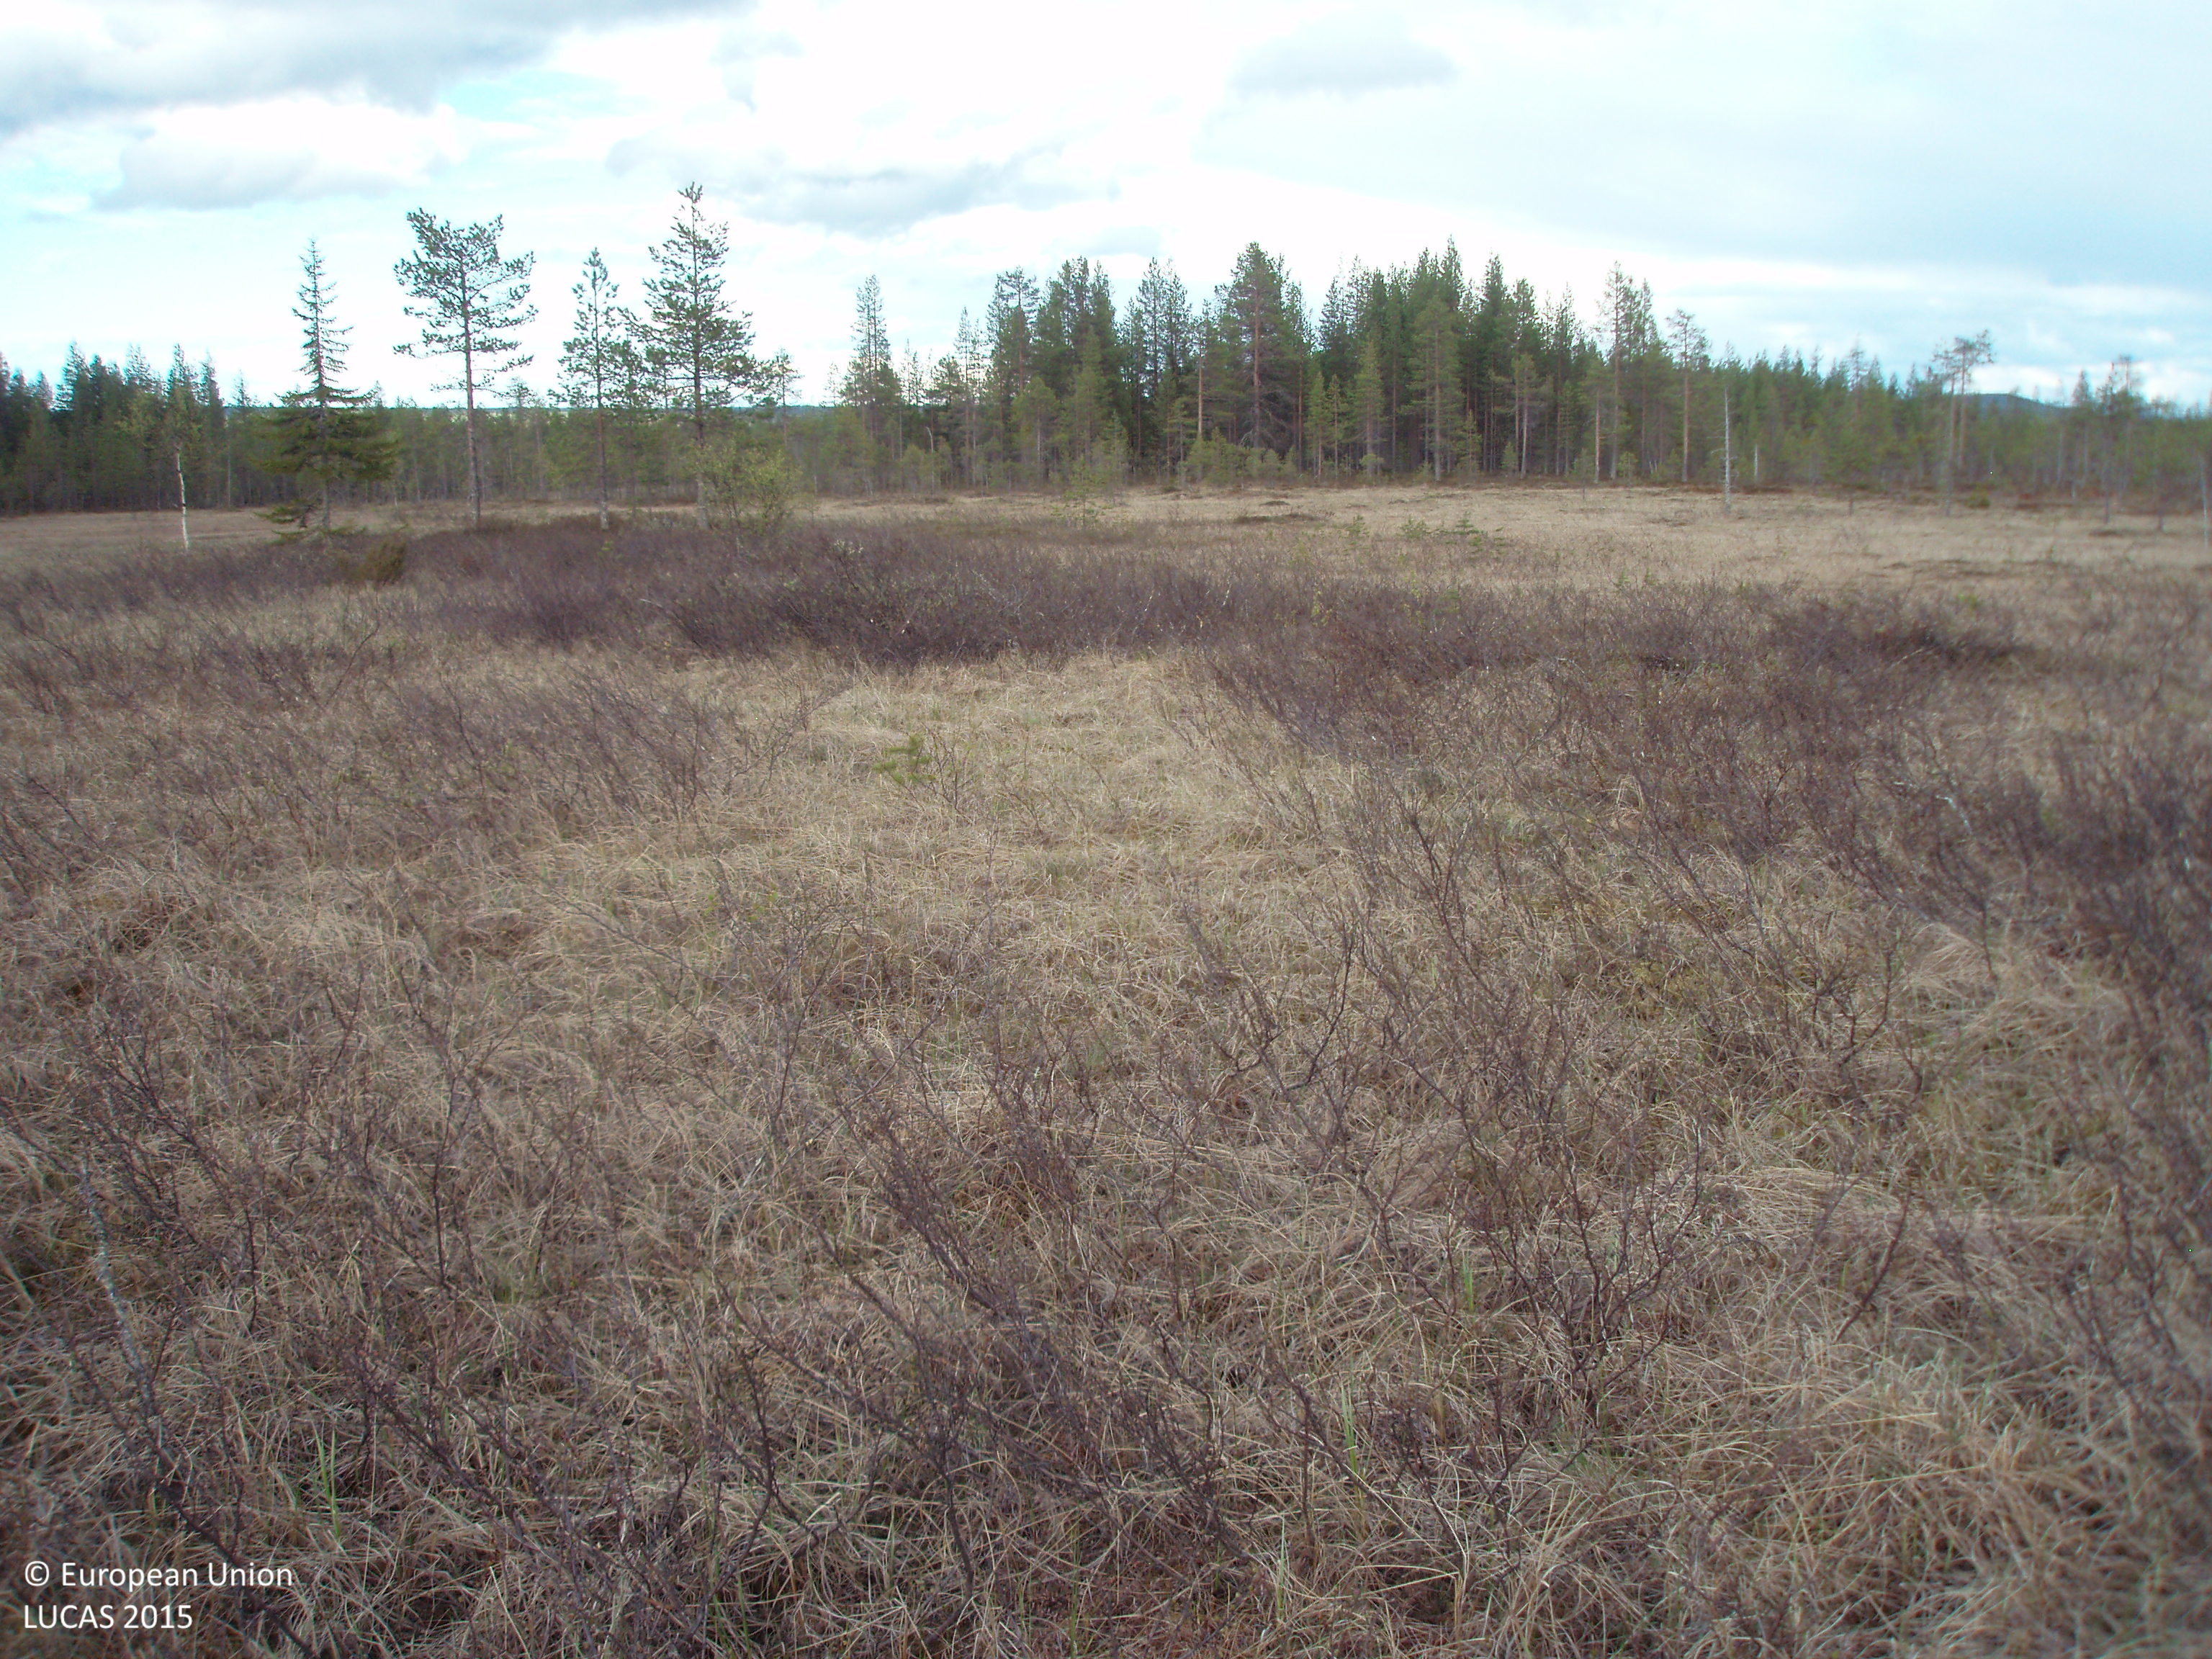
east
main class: Shrubland
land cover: Shrubland with sparse tree cover
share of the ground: 50 - 75 %
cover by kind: shrubs 45 %, herbaceous plants 35 %, lichens and mosses 15 %, coniferous forest trees 5 %
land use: Semi-natural and natural areas not in use
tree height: > 5 m
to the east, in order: Shrubland with sparse tree cover; Peatbogs; Pine dominated coniferous woodland; Peatbogs; Rivers and streams; Peatbogs
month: June
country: FI
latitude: 66.6876
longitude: 26.6408
